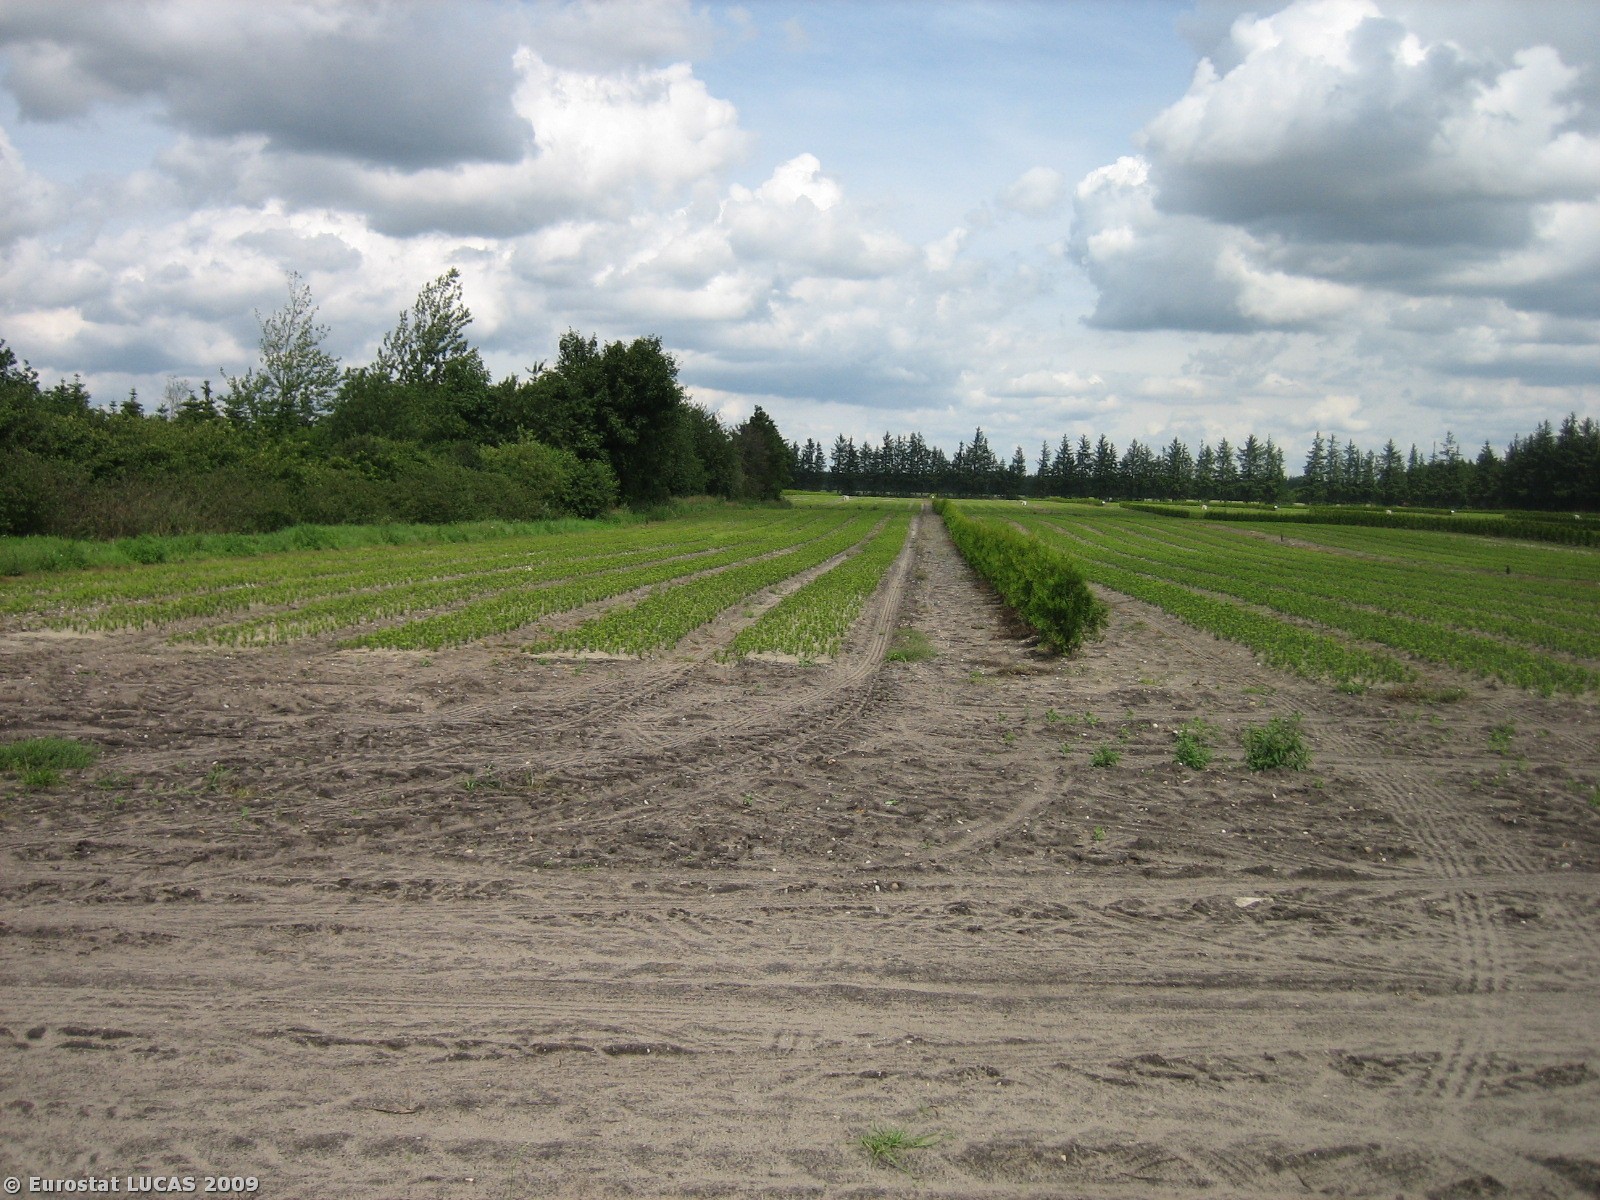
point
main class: Cropland
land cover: Nurseries
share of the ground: 50 - 75 %
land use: Agriculture (excluding fallow land and kitchen gardens)
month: July
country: DK
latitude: 55.8058
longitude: 8.9321
